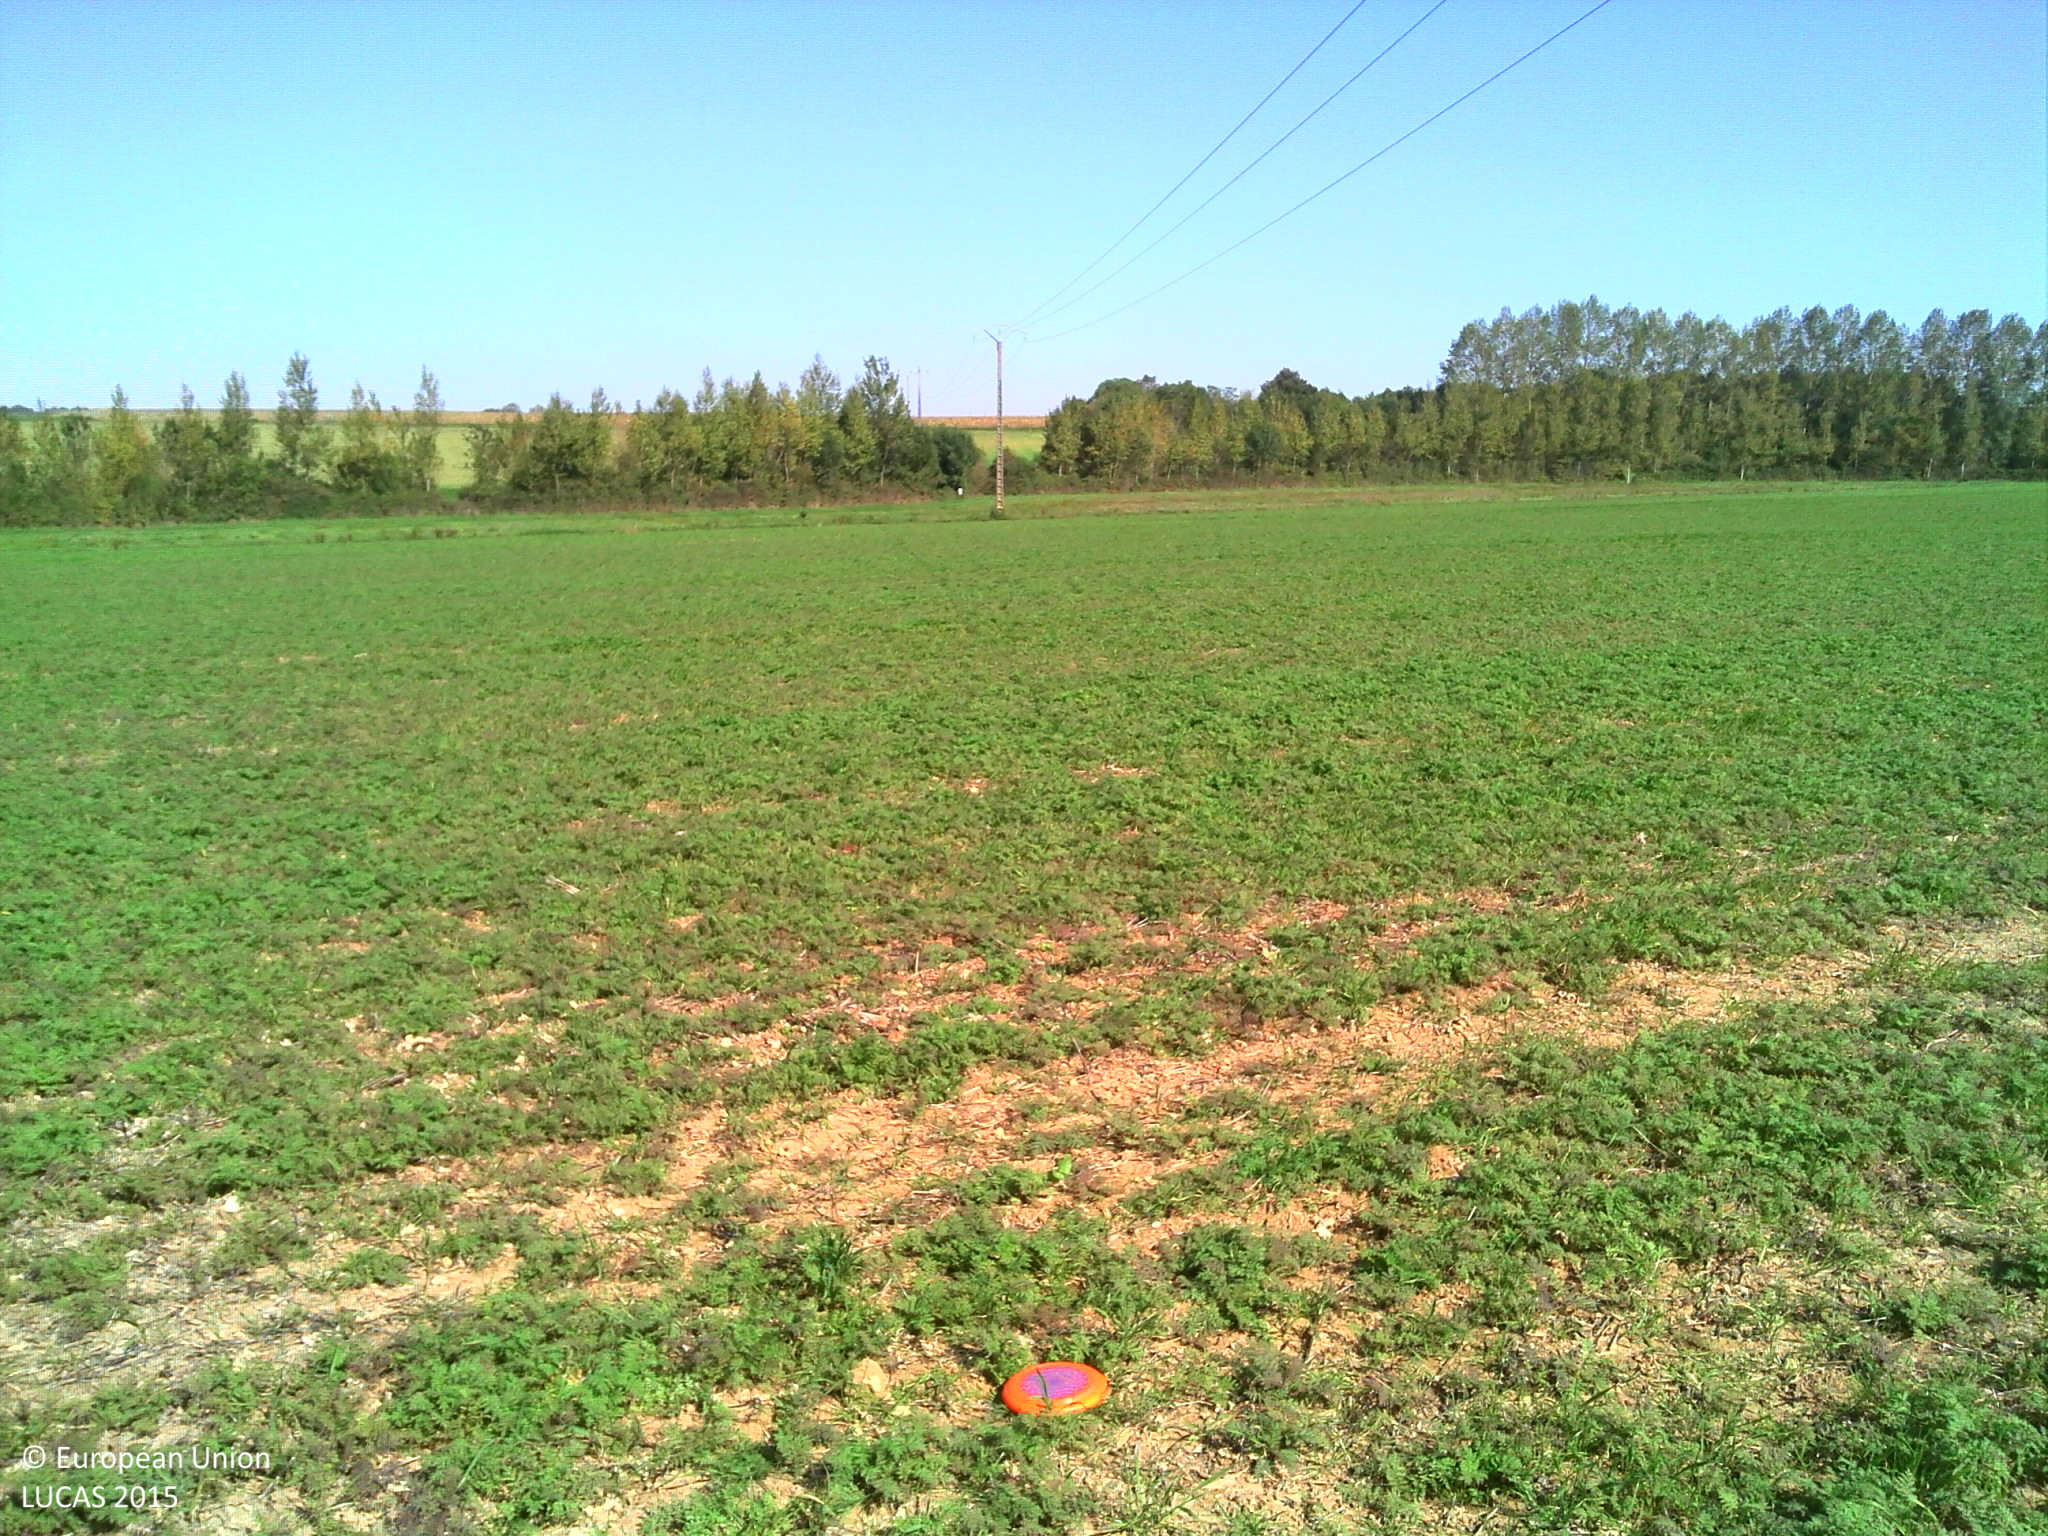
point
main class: Cropland
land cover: Other leguminous and mixtures for fodder
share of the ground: 25 - 50 %
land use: Agriculture (excluding fallow land and kitchen gardens)
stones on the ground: < 10 %
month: September
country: FR
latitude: 46.5318
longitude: -1.1287
